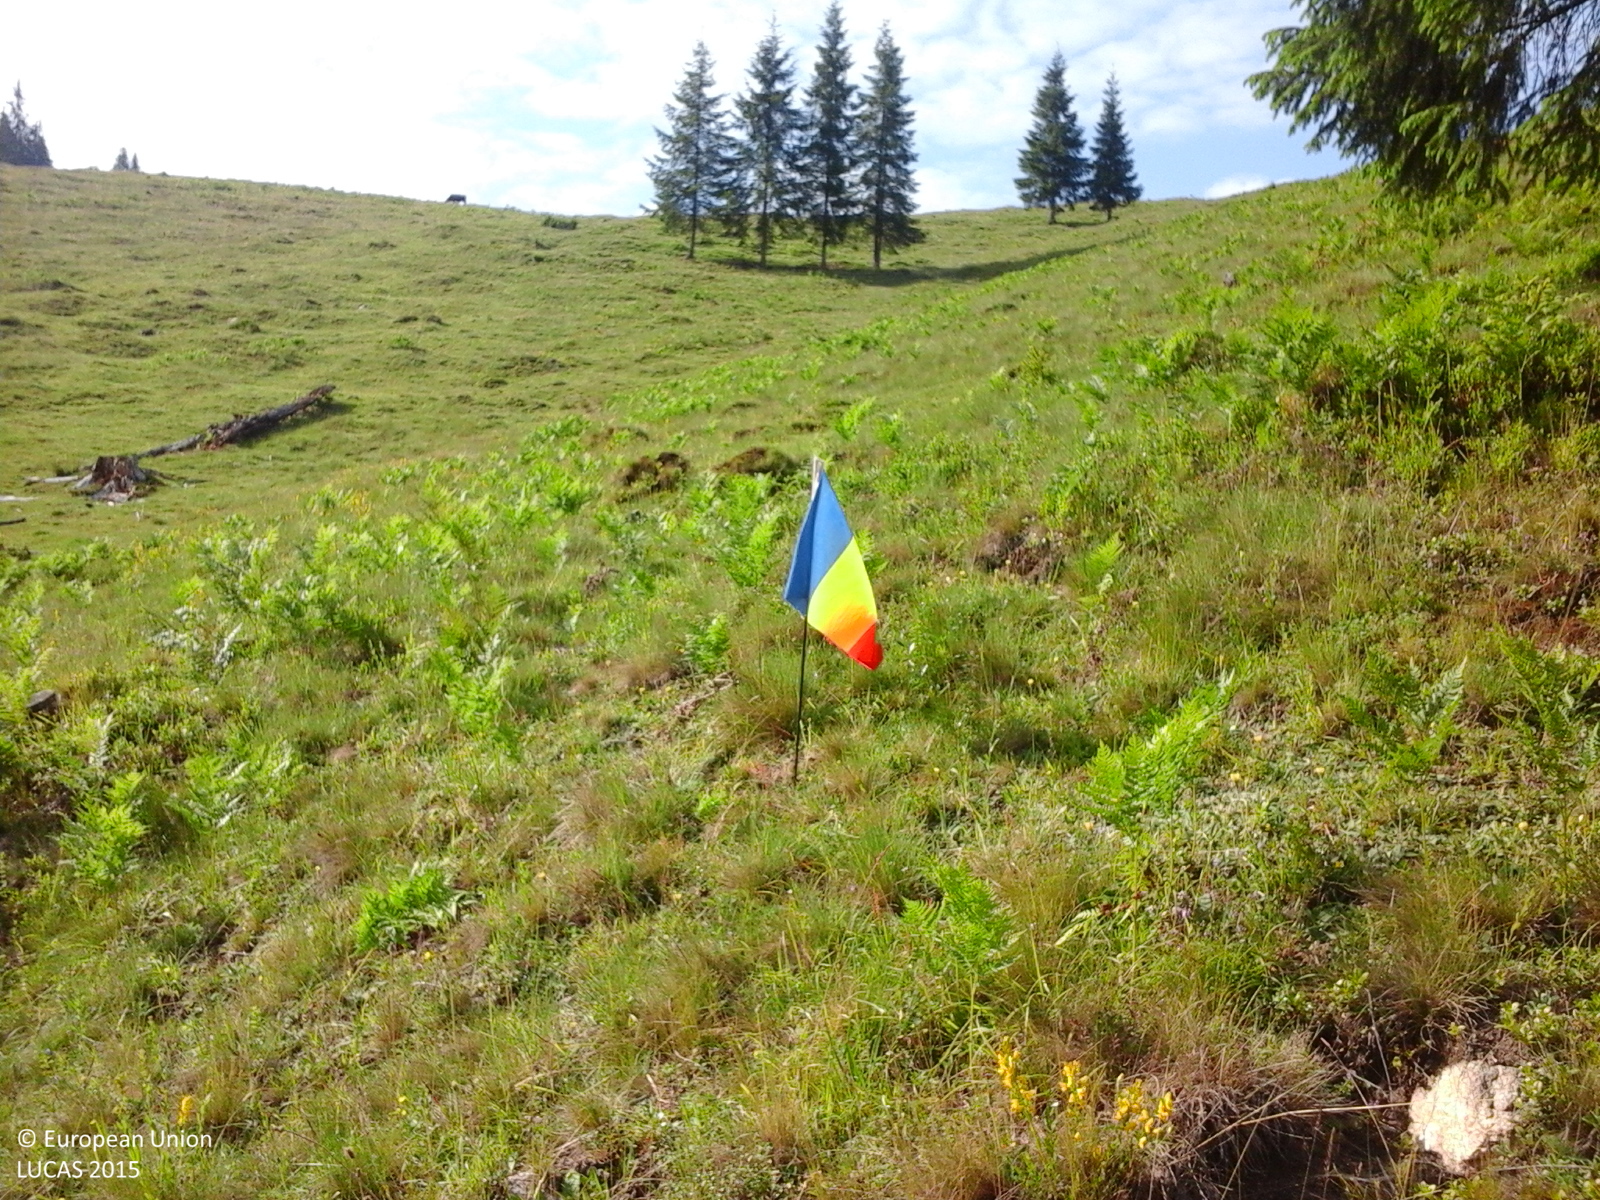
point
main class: Grassland
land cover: Grassland without tree/shrub cover
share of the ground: > 75 %
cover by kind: herbaceous plants 100 %
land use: Agriculture (excluding fallow land and kitchen gardens)
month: June
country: RO
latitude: 47.4901
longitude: 25.3359
